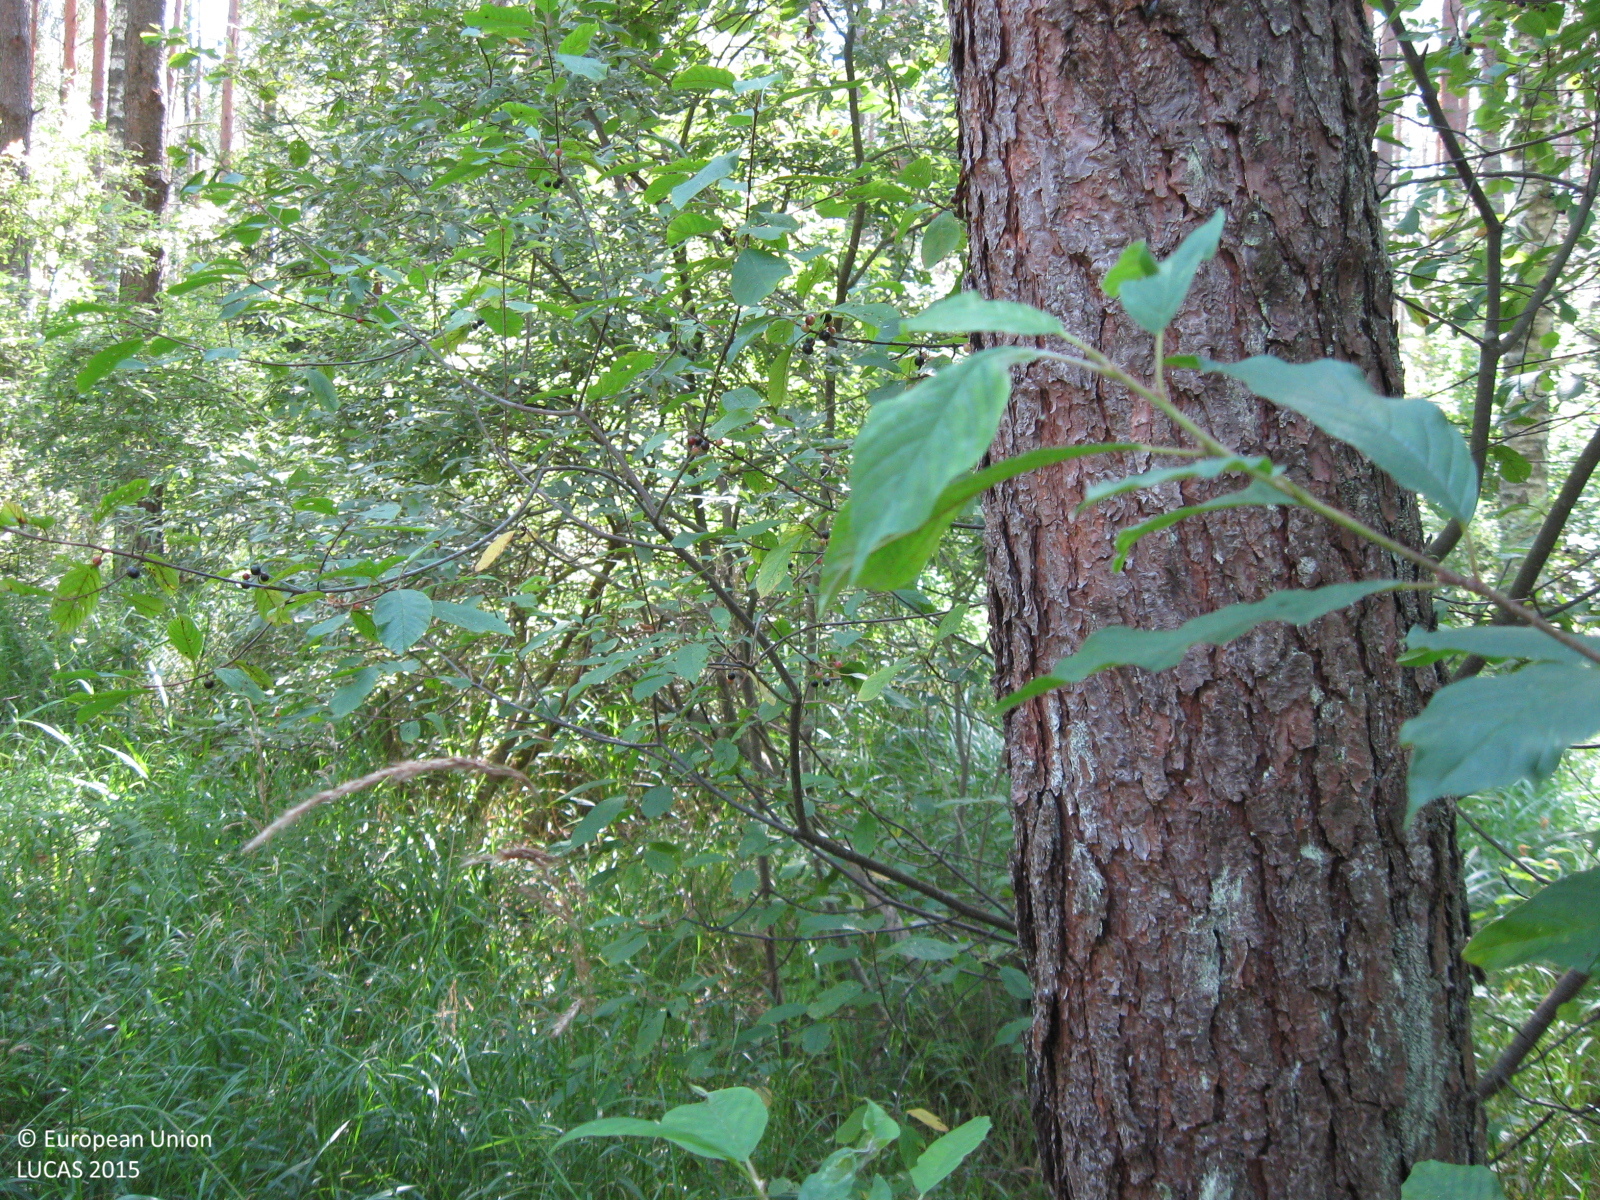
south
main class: Woodland
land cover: Pine dominated mixed woodland
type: hemiboreal forest and nemoral coniferous forest and mixed broadleaved-coniferous forest
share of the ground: > 75 %
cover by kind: coniferous forest trees 60 %, broadleaved forest trees 30 %, herbaceous plants 10 %
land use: Forestry
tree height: > 5 m
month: August
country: LT
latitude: 55.3044
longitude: 22.4583
